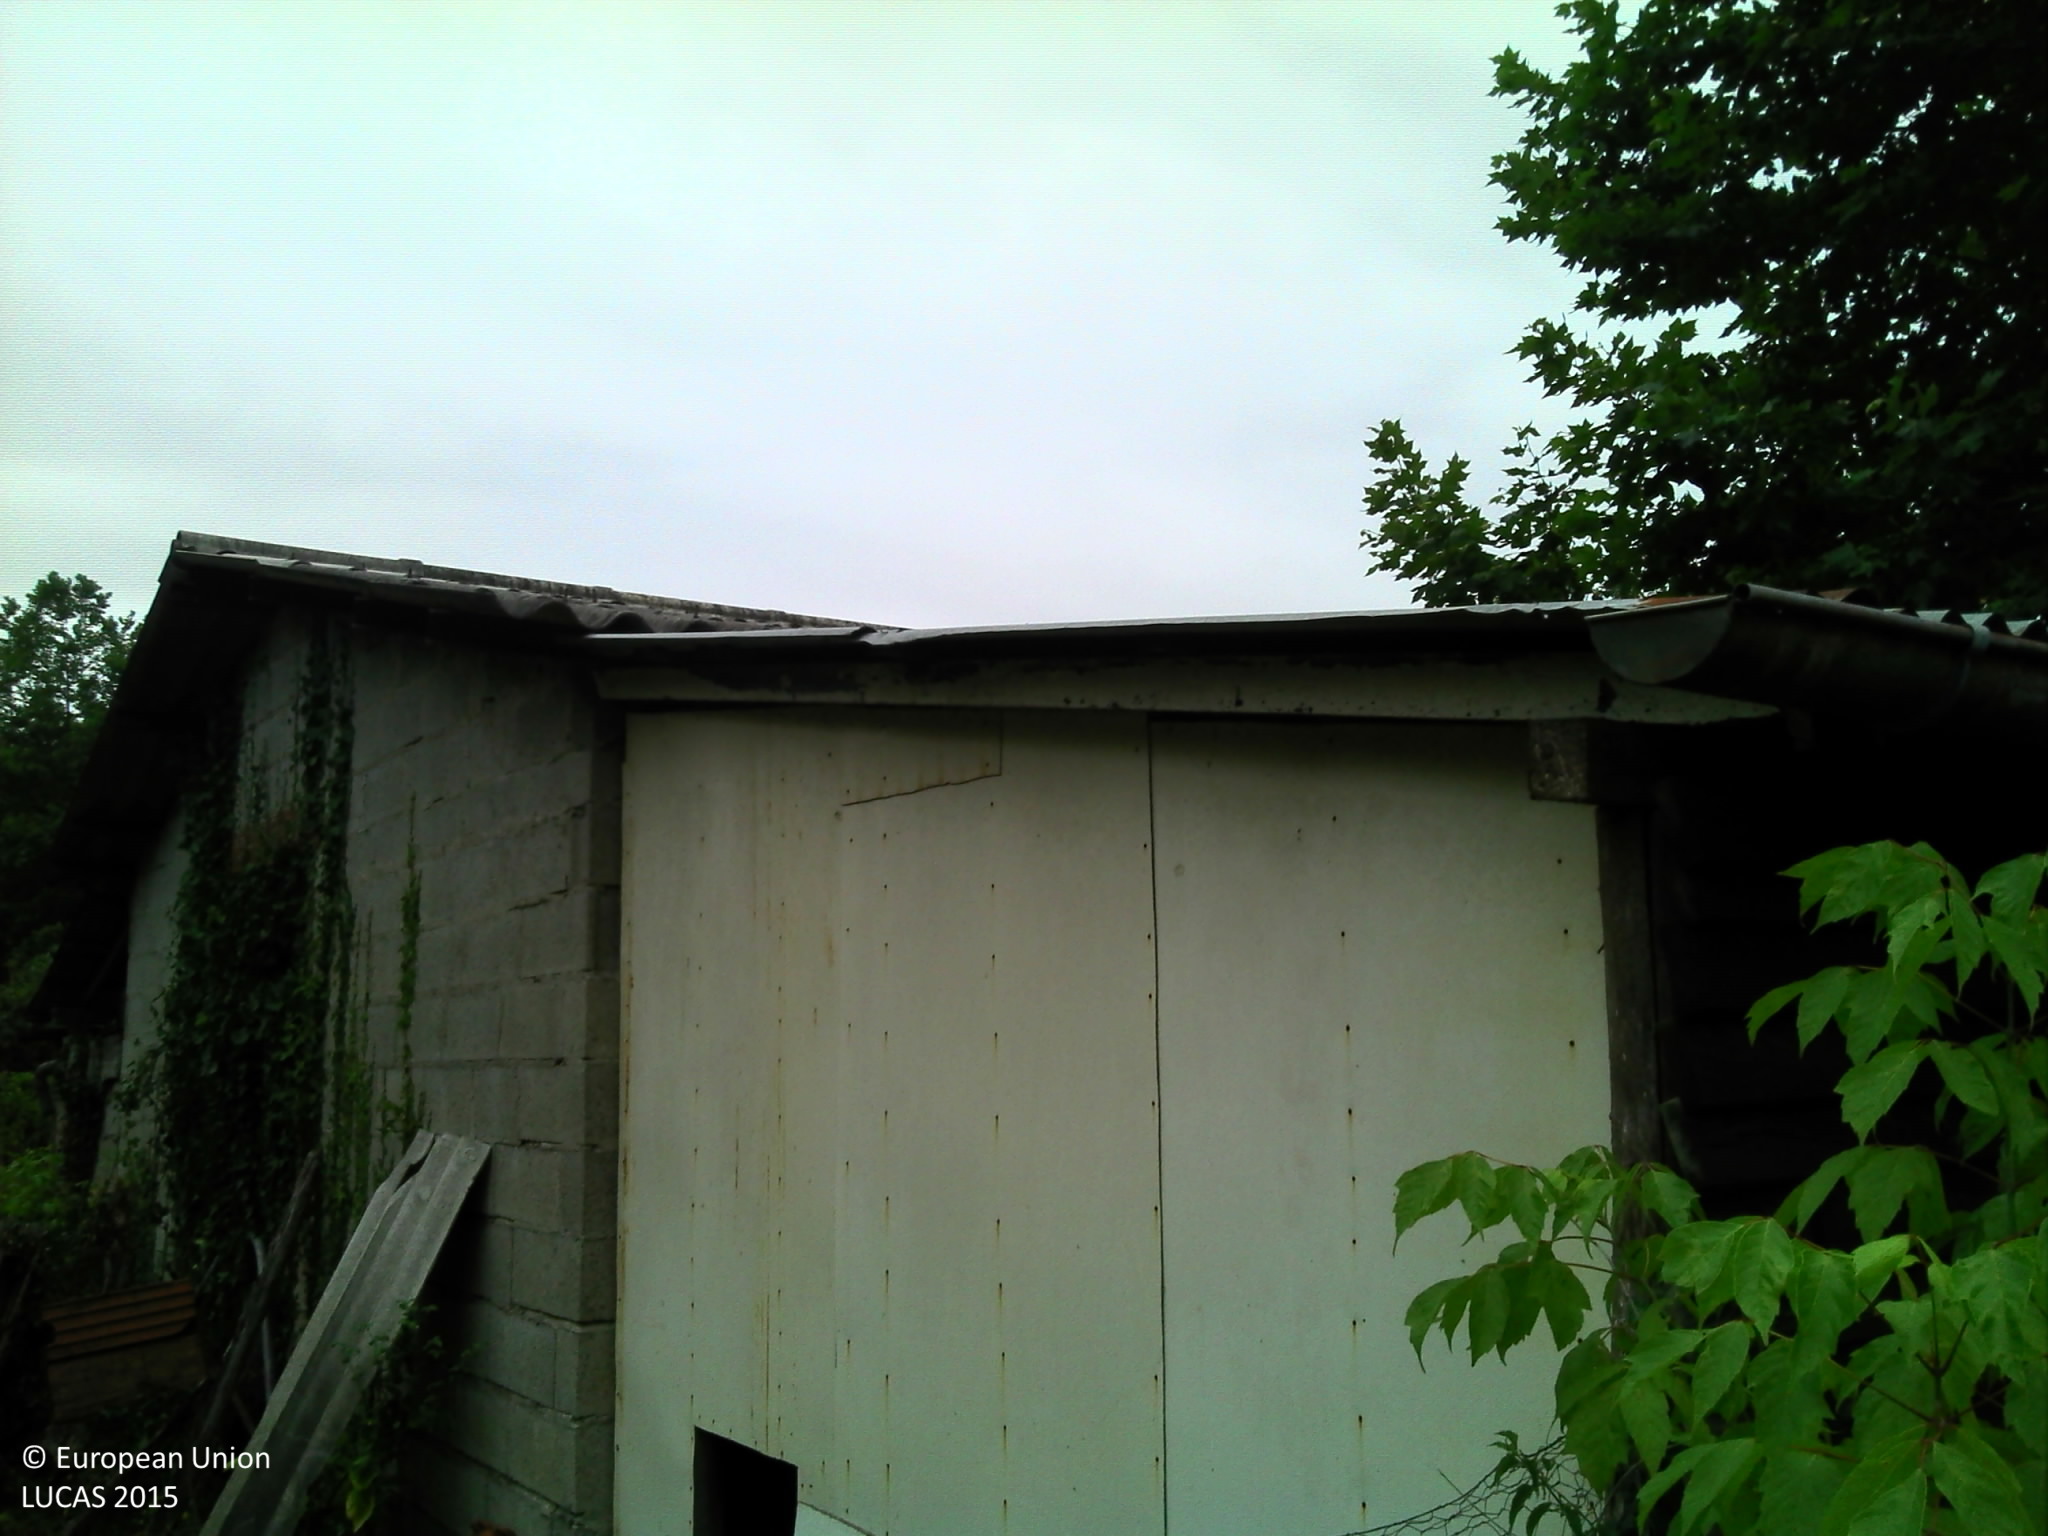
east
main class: Grassland
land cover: Grassland without tree/shrub cover
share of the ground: > 75 %
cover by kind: herbaceous plants 100 %
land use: Residential
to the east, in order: Grassland without tree/shrub cover; Conifer hedges; Artificial constructions in urban areas; Abandoned hedges; Maize; Ditches and canals; Paved roads, cycling and walking lanes; Ditches and canals; Maize
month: July
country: FR
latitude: 43.5992
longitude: -1.1775
